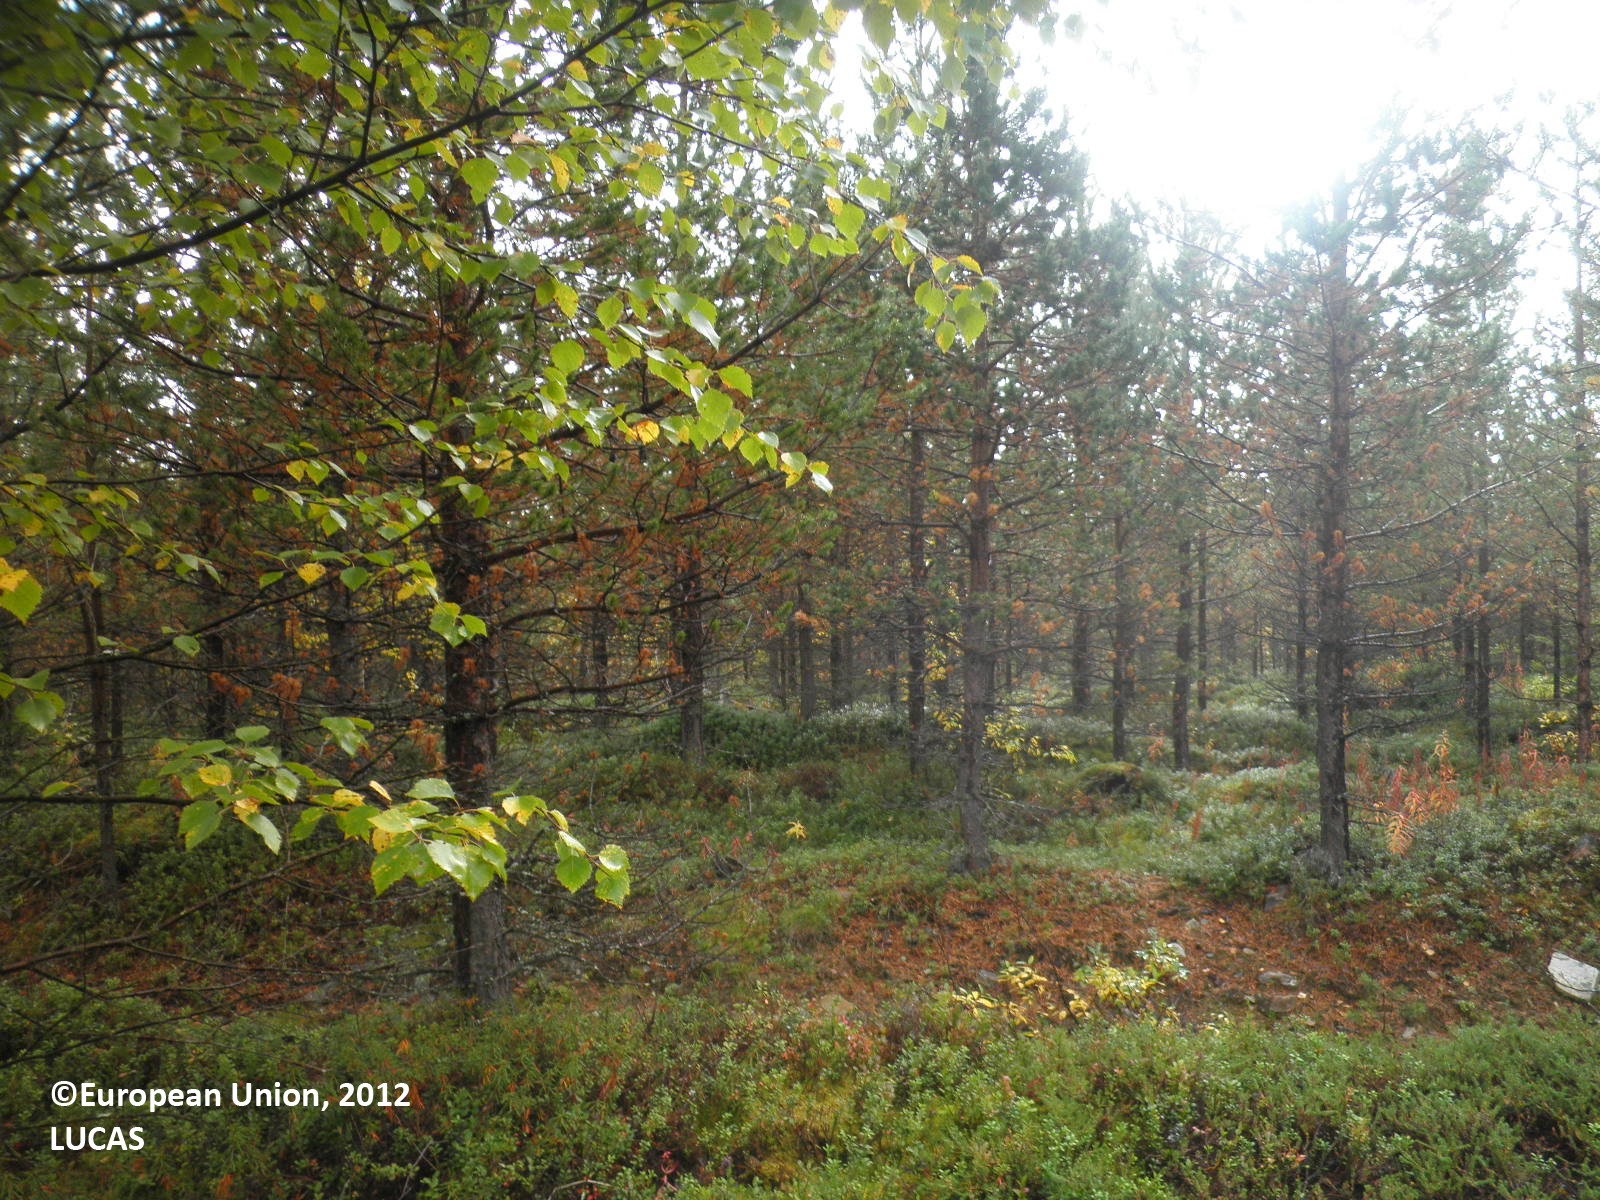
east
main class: Woodland
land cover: Pine dominated coniferous woodland
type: boreal forest
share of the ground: 50 - 75 %
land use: Forestry
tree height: > 5 m
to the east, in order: Pine dominated coniferous woodland; Ditches and canals; Pine dominated coniferous woodland; Ditches and canals; Pine dominated coniferous woodland; Ditches and canals; Pine dominated coniferous woodland; Ditches and canals; Pine dominated coniferous woodland; Ditches and canals; Pine dominated coniferous woodland; Ditches and canals; Pine dominated coniferous woodland; Ditches and canals; Pine dominated coniferous woodland; Ditches and canals; Pine dominated coniferous woodland; Ditches and canals; Pine dominated coniferous woodland; Ditches and canals; Pine dominated coniferous woodland; Ditches and canals; Pine dominated coniferous woodland; Ditches and canals; Tracks; Pine dominated mixed woodland; Ditches and canals; Pine dominated mixed woodland; Ditches and canals; Pine dominated mixed woodland; Ditches and canals; Pine dominated mixed woodland; Ditches and canals; Pine dominated mixed woodland; Ditches and canals; Pine dominated mixed woodland; Ditches and canals; Pine dominated mixed woodland; Ditches and canals; Pine dominated mixed woodland; Ditches and canals; Pine dominated mixed woodland; Ditches and canals; Pine dominated mixed woodland; Ditches and canals; Pine dominated mixed woodland; Ditches and canals; Pine dominated mixed woodland; Ditches and canals; Pine dominated mixed woodland; Ditches and canals; Pine dominated mixed woodland; Ditches and canals; Pine dominated mixed woodland; Ditches and canals; Pine dominated mixed woodland; Ditches and canals; Pine dominated mixed woodland; Ditches and canals; Pine dominated mixed woodland; Ditches and canals; Pine dominated mixed woodland; Ditches and canals; Pine dominated mixed woodland; Ditches and canals; Pine dominated mixed woodland; Ditches and canals
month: September
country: FI
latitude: 67.2414
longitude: 28.1675
